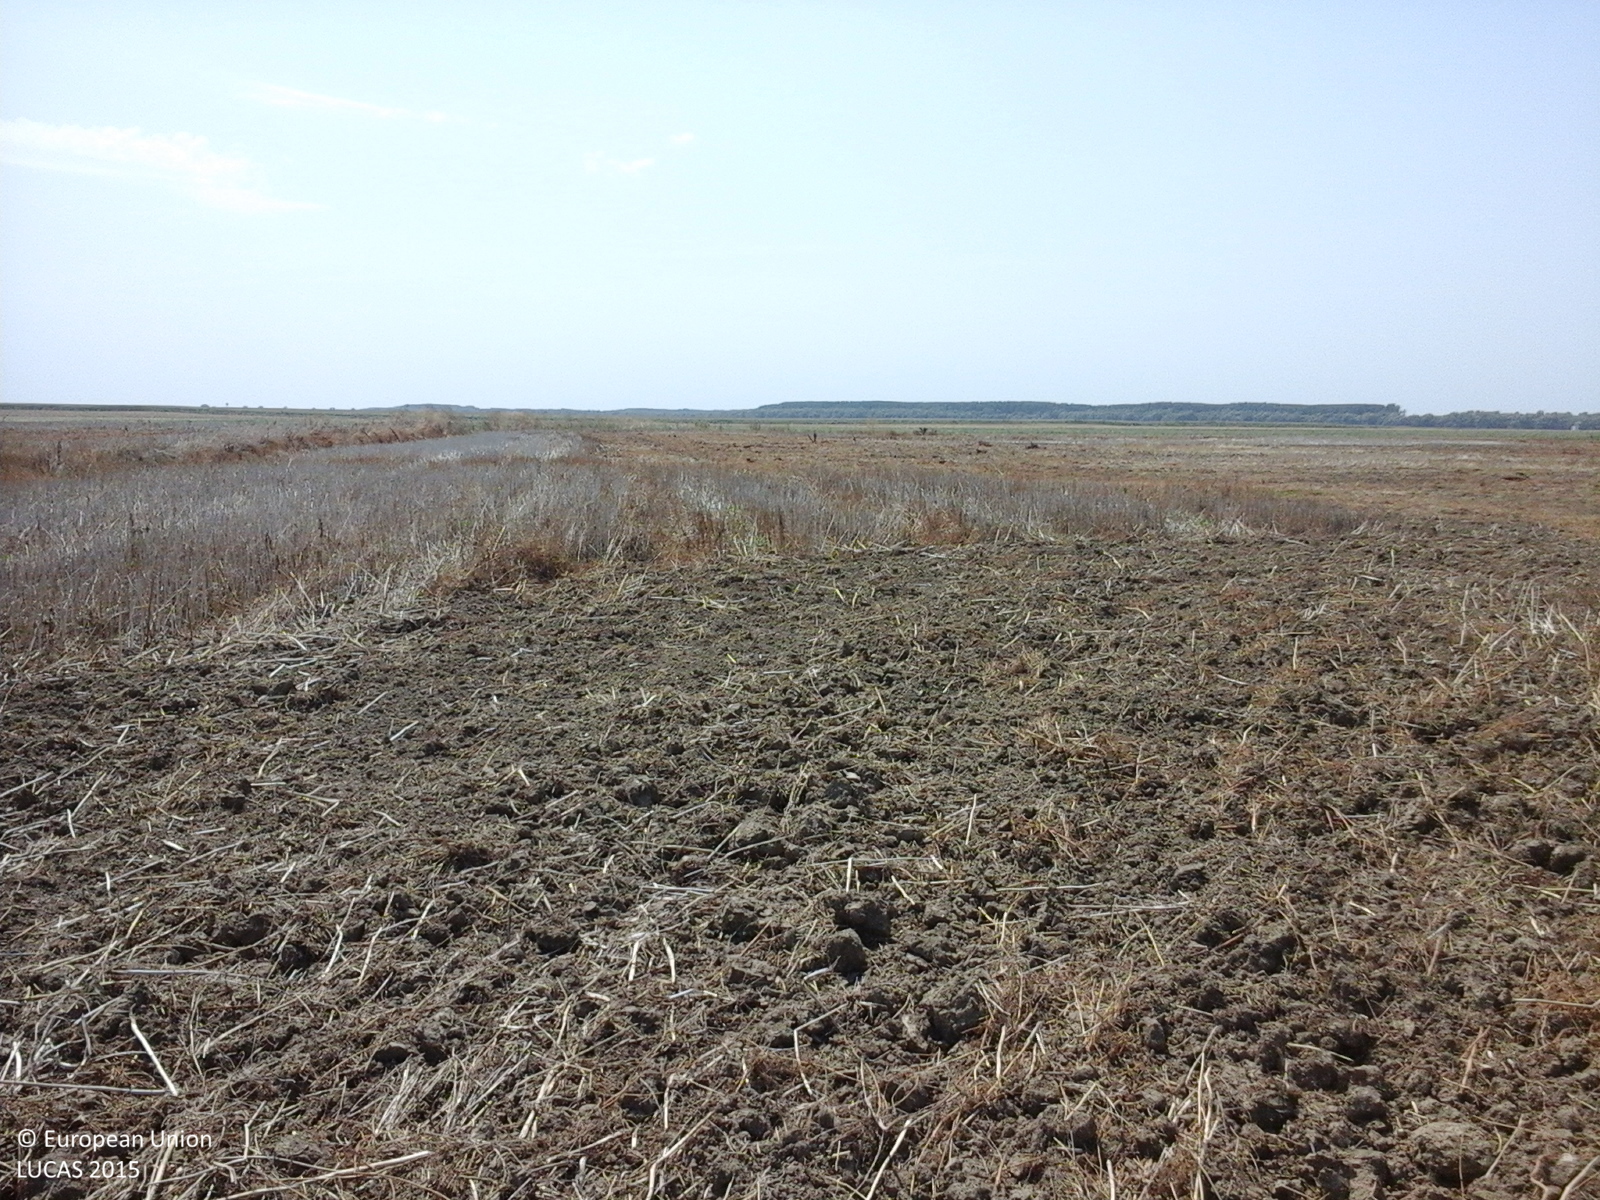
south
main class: Cropland
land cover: Rape and turnip rape
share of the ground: < 10 %
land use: Agriculture (excluding fallow land and kitchen gardens)
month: August
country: RO
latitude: 45.0600
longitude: 27.9280
